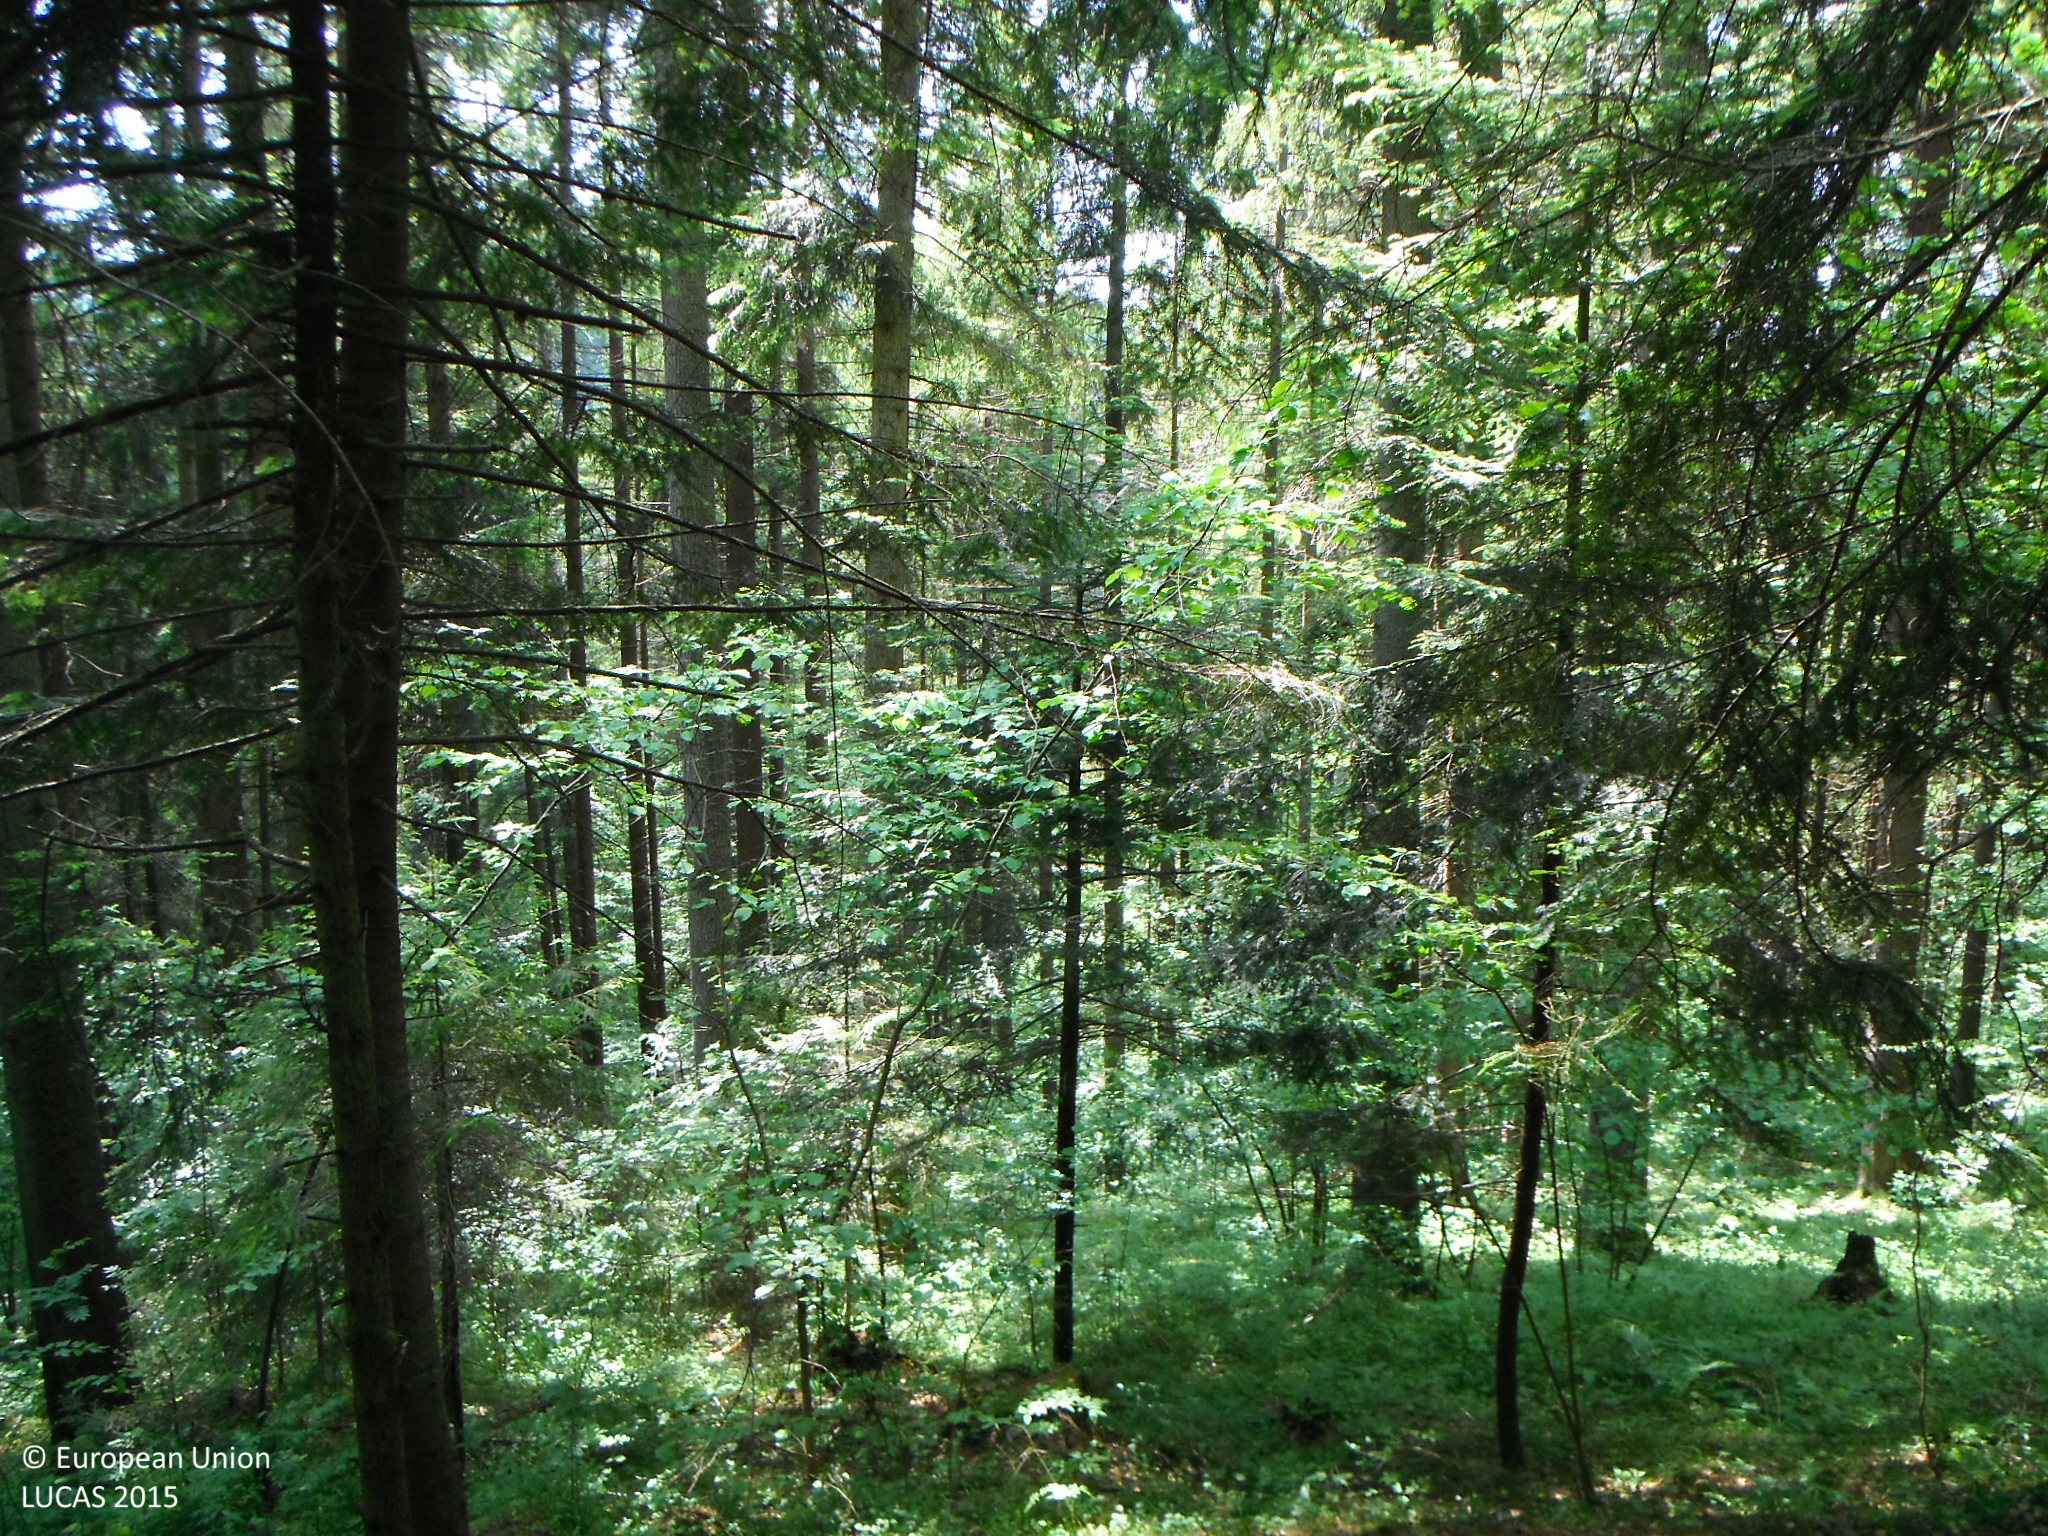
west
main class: Woodland
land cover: Spruce dominated coniferous woodland
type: alpine coniferous forest
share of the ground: > 75 %
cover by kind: coniferous forest trees 90 %, broadleaved forest trees 10 %
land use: Forestry
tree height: > 5 m
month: June
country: SK
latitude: 48.7826
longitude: 19.5939
